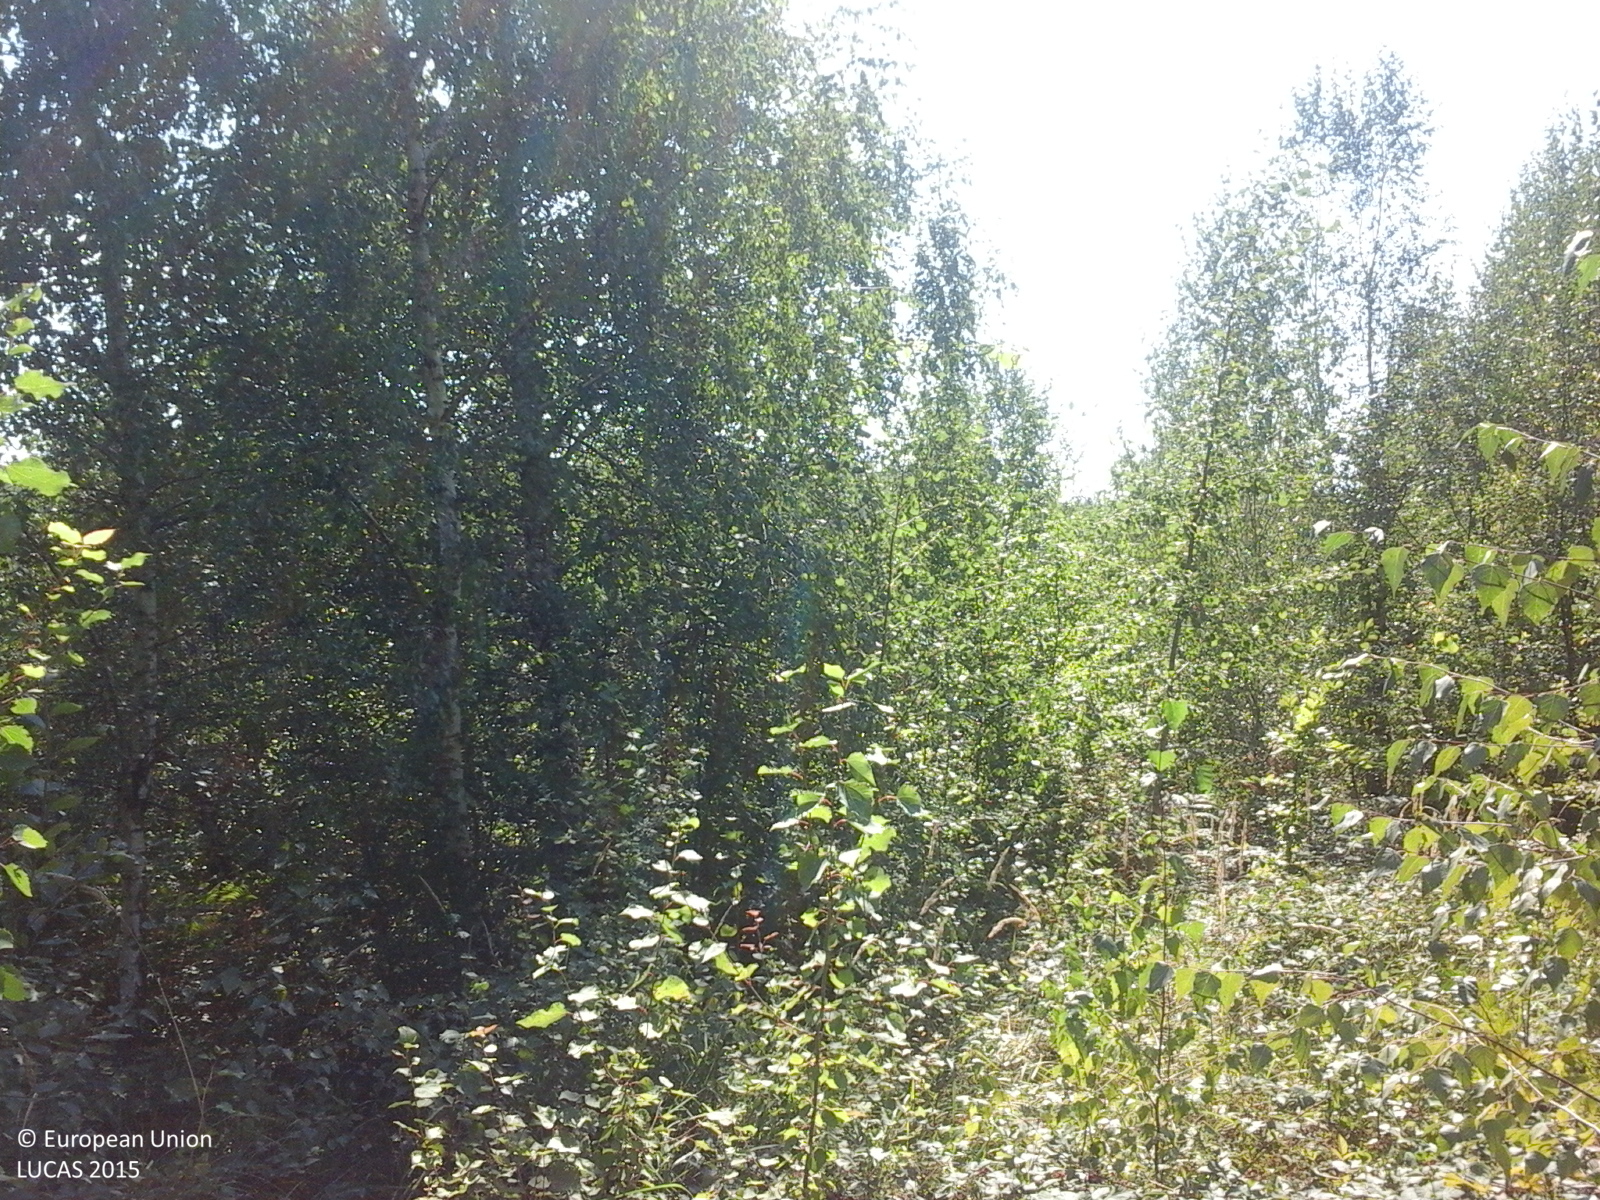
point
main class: Woodland
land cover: Broadleaved woodland
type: broadleaved evergreen forest
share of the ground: > 75 %
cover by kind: broadleaved forest trees 100 %
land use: Forestry
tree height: > 5 m
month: September
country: RO
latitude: 47.1665
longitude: 22.4685
